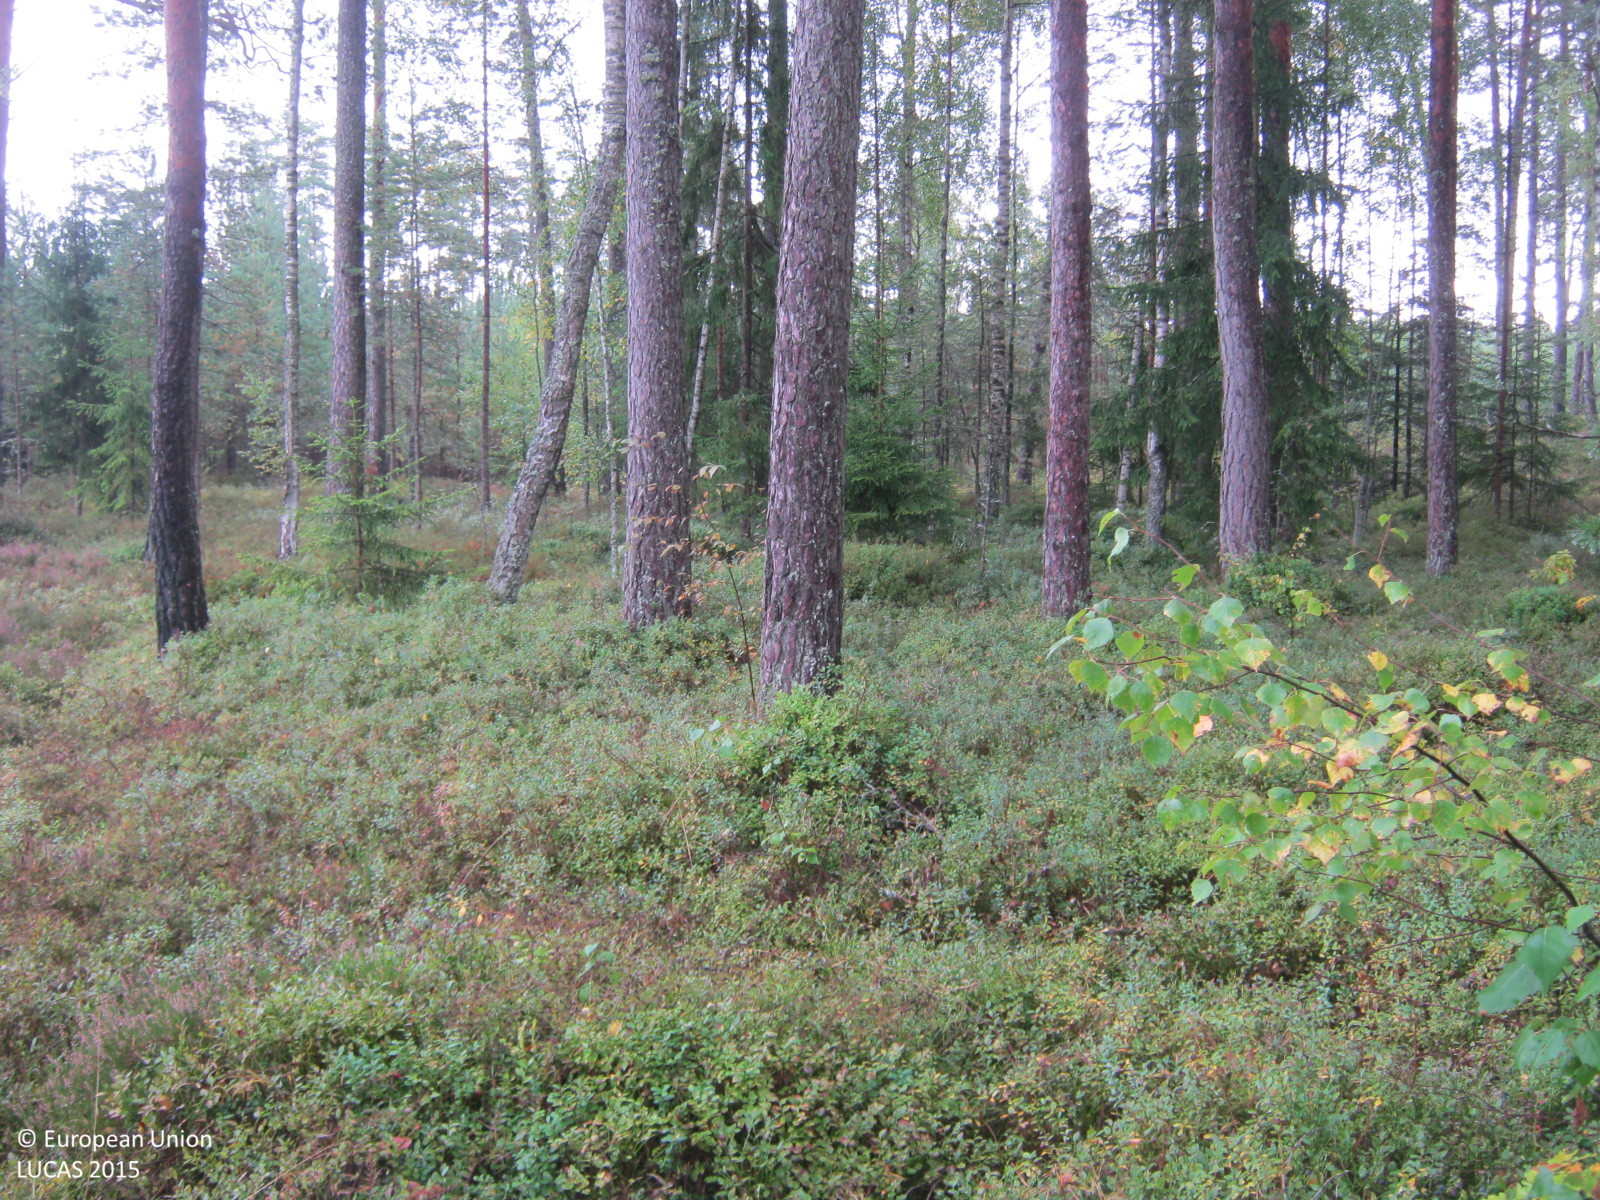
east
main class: Woodland
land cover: Pine dominated coniferous woodland
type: hemiboreal forest and nemoral coniferous forest and mixed broadleaved-coniferous forest
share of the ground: 50 - 75 %
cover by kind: coniferous forest trees 70 %, broadleaved forest trees 10 %, lichens and mosses 10 %, shrubs 5 %, herbaceous plants 5 %
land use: Forestry
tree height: > 5 m
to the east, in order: Pine dominated coniferous woodland; Grass margins; Fences; Grassland without tree/shrub cover; Ditches and canals; Grassland without tree/shrub cover; Fences; Paved roads, cycling and walking lanes; Grass margins; Ditches and canals; Grass margins; Pine dominated coniferous woodland; Grassland without tree/shrub cover; Ditches and canals; Grass margins; Fences; Paved roads, cycling and walking lanes; Grass margins; Ditches and canals; Grassland without tree/shrub cover; Pine dominated coniferous woodland; Grassland without tree/shrub cover; Ditches and canals; Grassland without tree/shrub cover; Fences; Paved roads, cycling and walking lanes; Fences; Grassland without tree/shrub cover; Ditches and canals; Grassland without tree/shrub cover; Fences; Pine dominated coniferous woodland
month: September
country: LV
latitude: 57.2694
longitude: 24.4349
